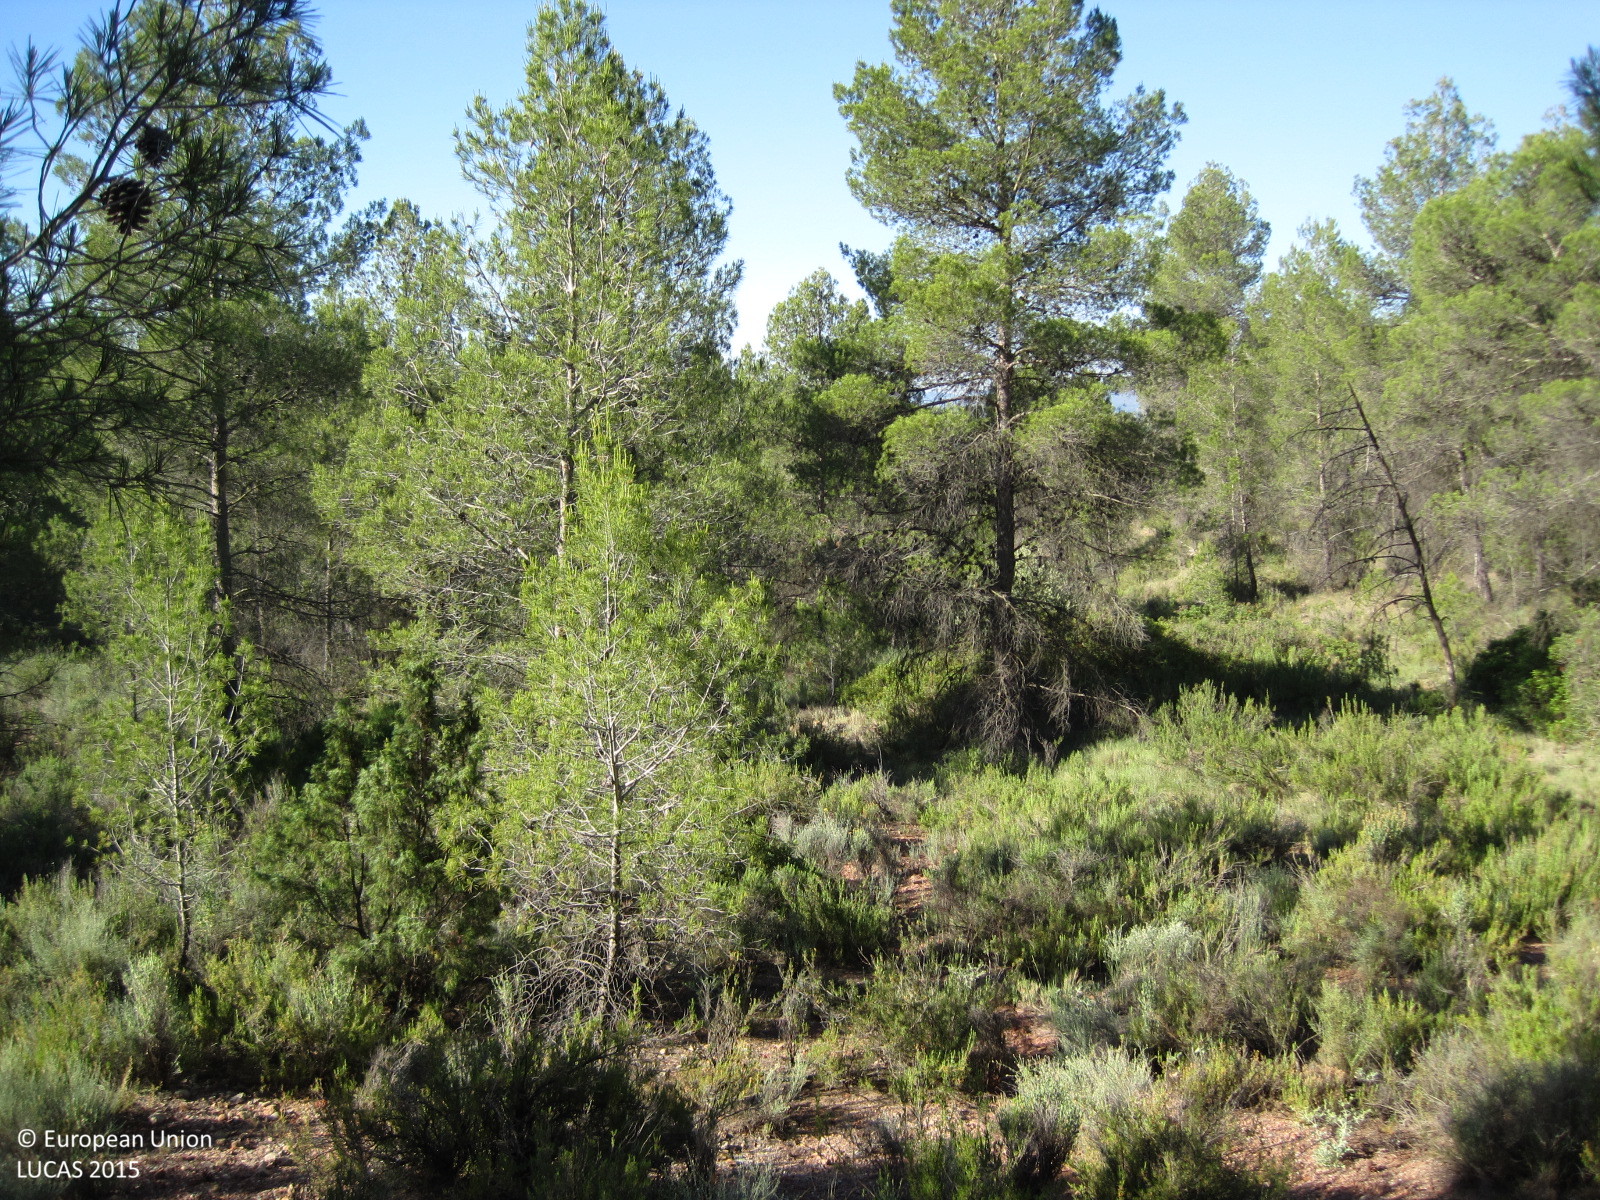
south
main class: Woodland
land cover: Pine dominated coniferous woodland
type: coniferous forest of the mediterranean region
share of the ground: 10 - 25 %
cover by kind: shrubs 30 %, herbaceous plants 25 %, unconsolidated bare surface 25 %, coniferous forest trees 20 %
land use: Forestry
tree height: > 5 m
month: June
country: ES
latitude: 39.2766
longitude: -1.0457
